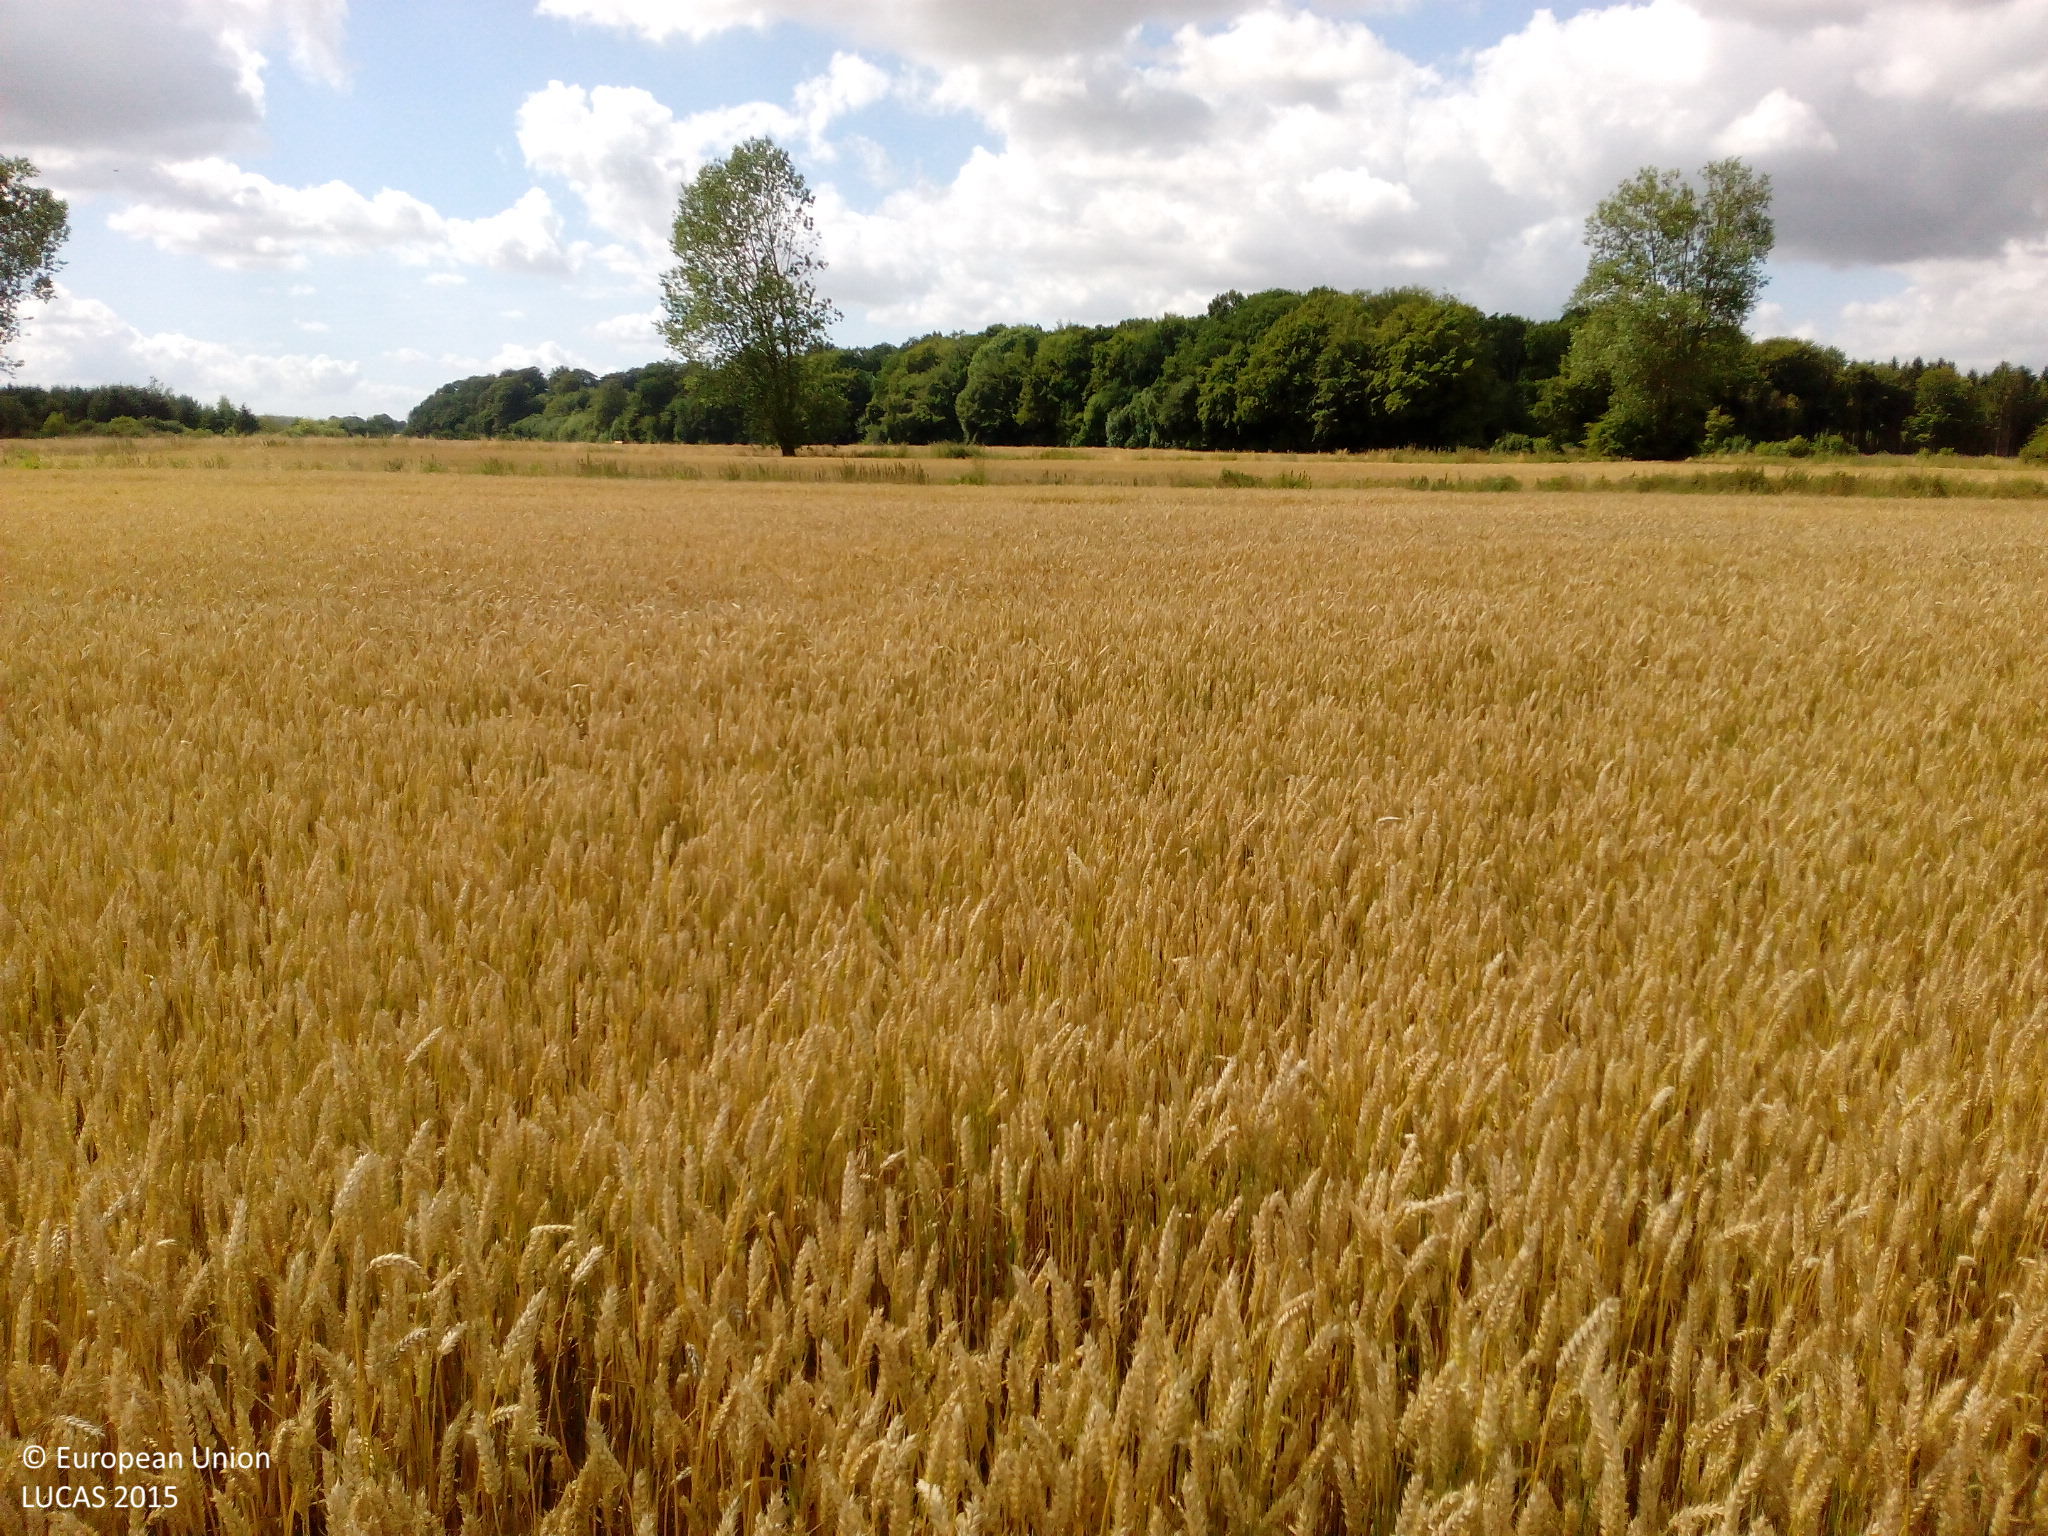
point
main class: Cropland
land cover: Common wheat
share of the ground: > 75 %
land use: Agriculture (excluding fallow land and kitchen gardens)
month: August
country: DK
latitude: 55.3604
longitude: 12.1595
